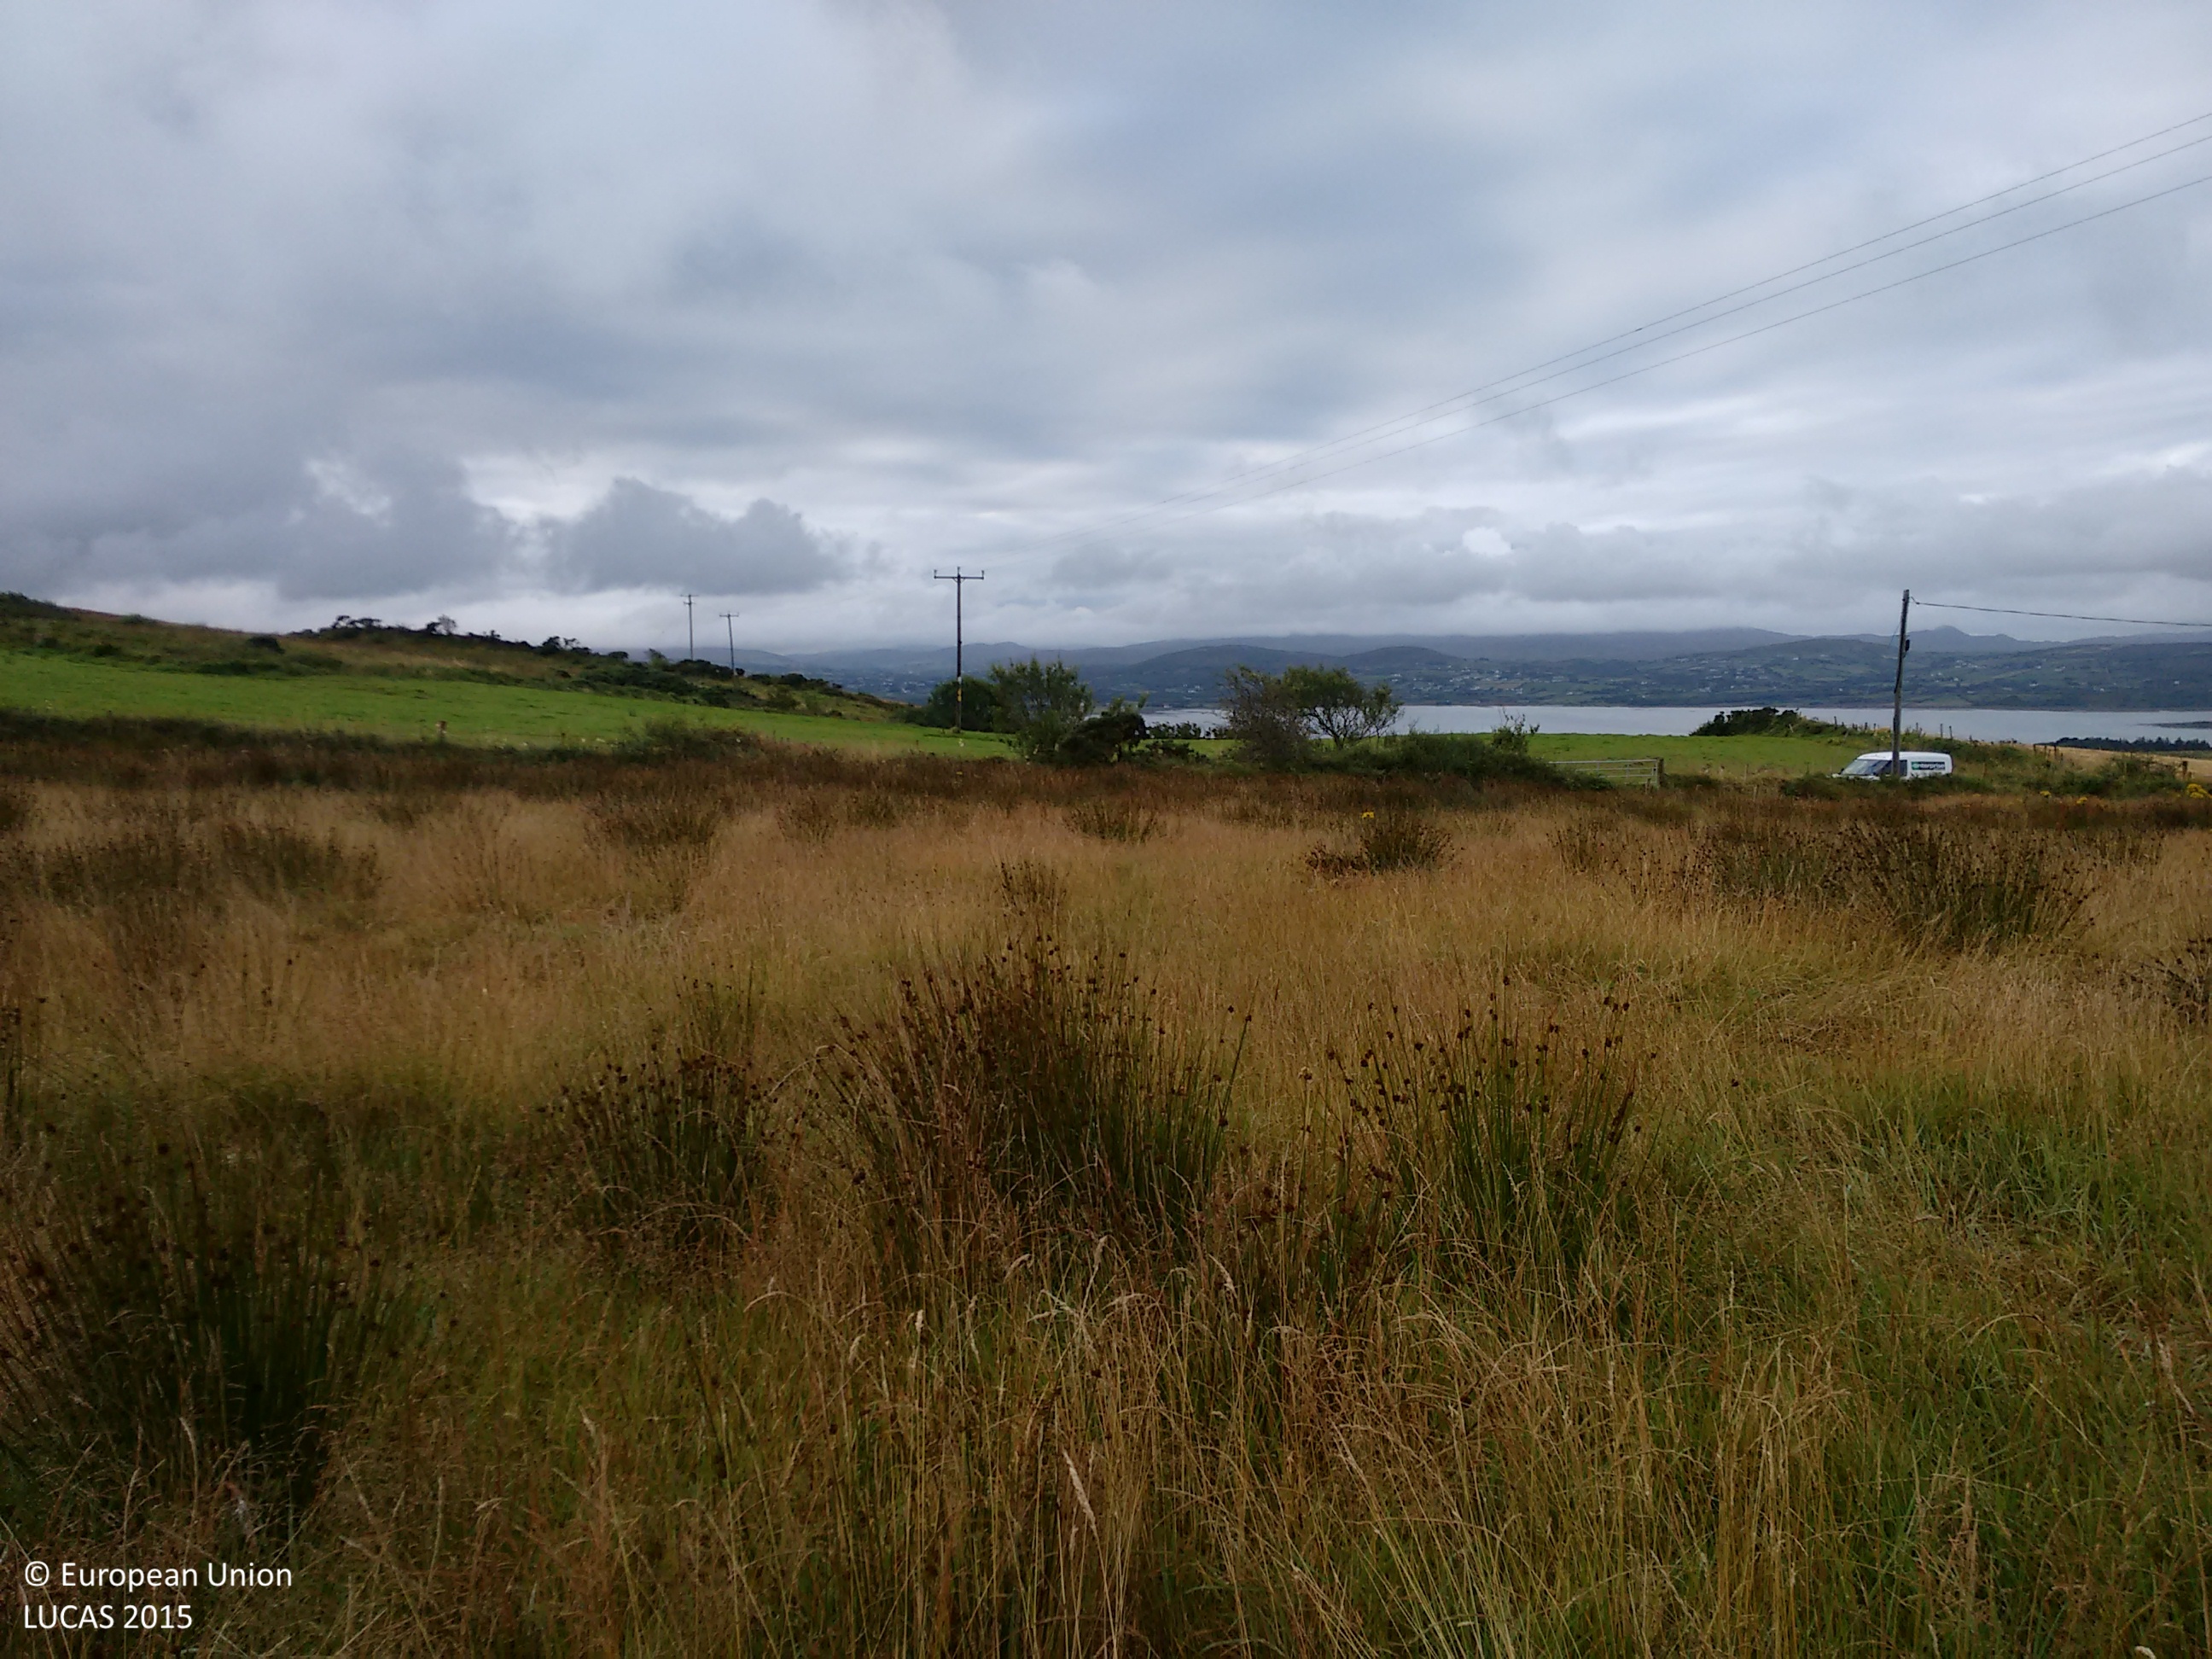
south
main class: Grassland
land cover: Grassland without tree/shrub cover
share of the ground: > 75 %
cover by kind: herbaceous plants 100 %
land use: Agriculture (excluding fallow land and kitchen gardens)
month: September
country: IE
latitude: 55.3159
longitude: -7.2734
